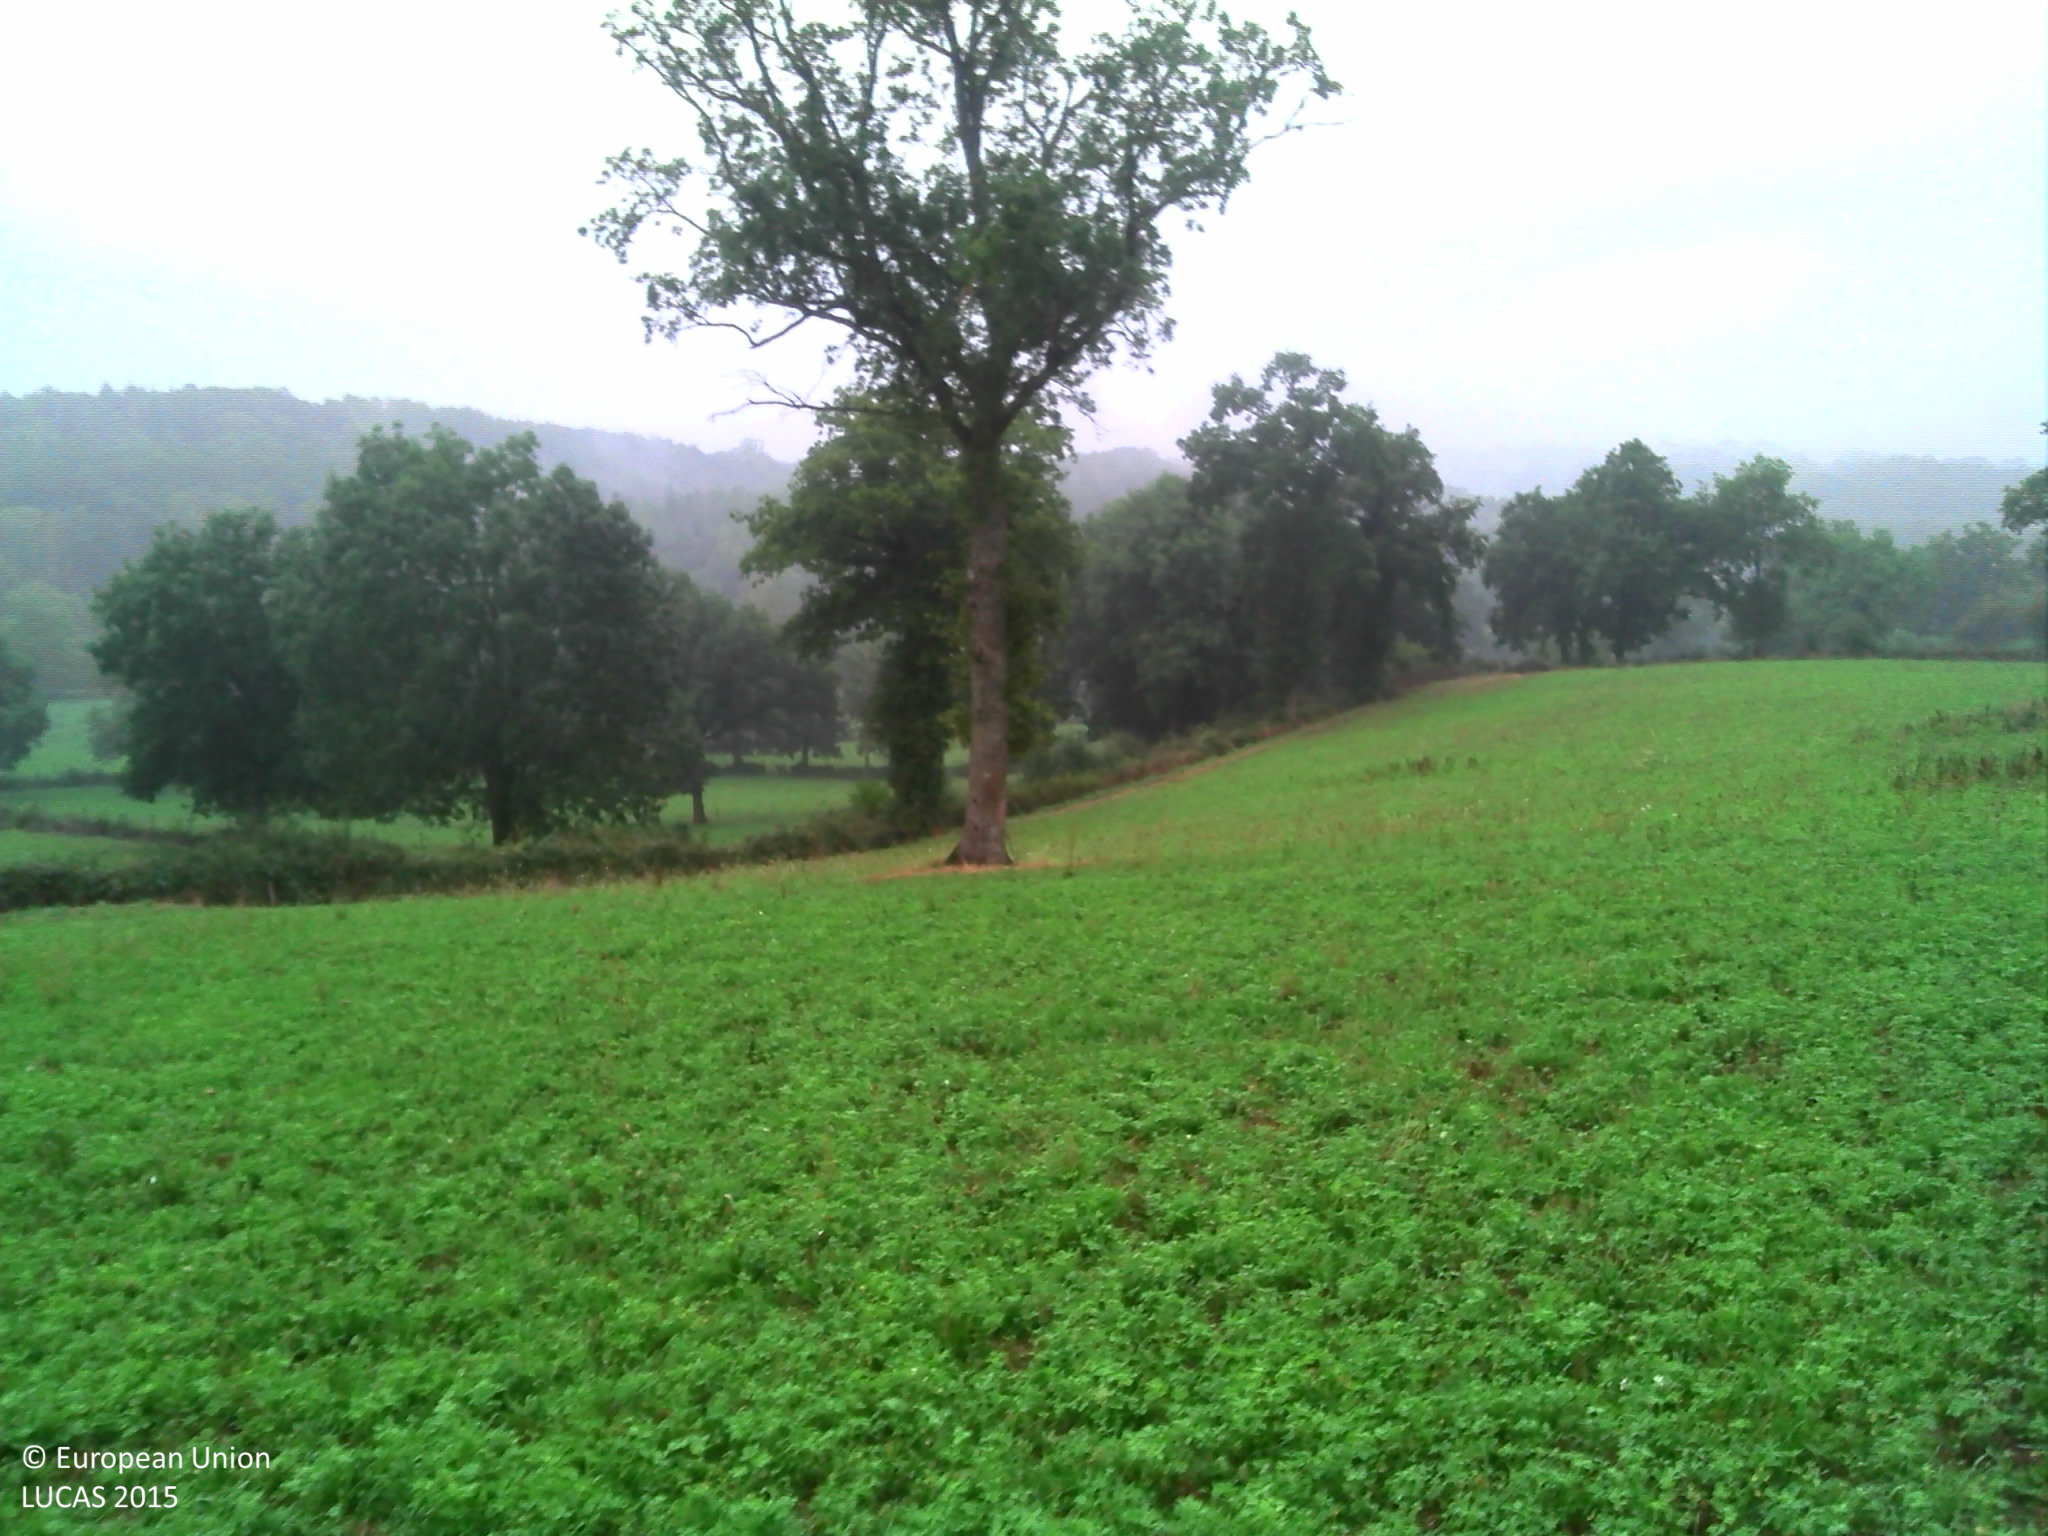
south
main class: Cropland
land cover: Lucerne
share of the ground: > 75 %
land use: Agriculture (excluding fallow land and kitchen gardens)
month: August
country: FR
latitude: 46.0754
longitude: 2.3282
